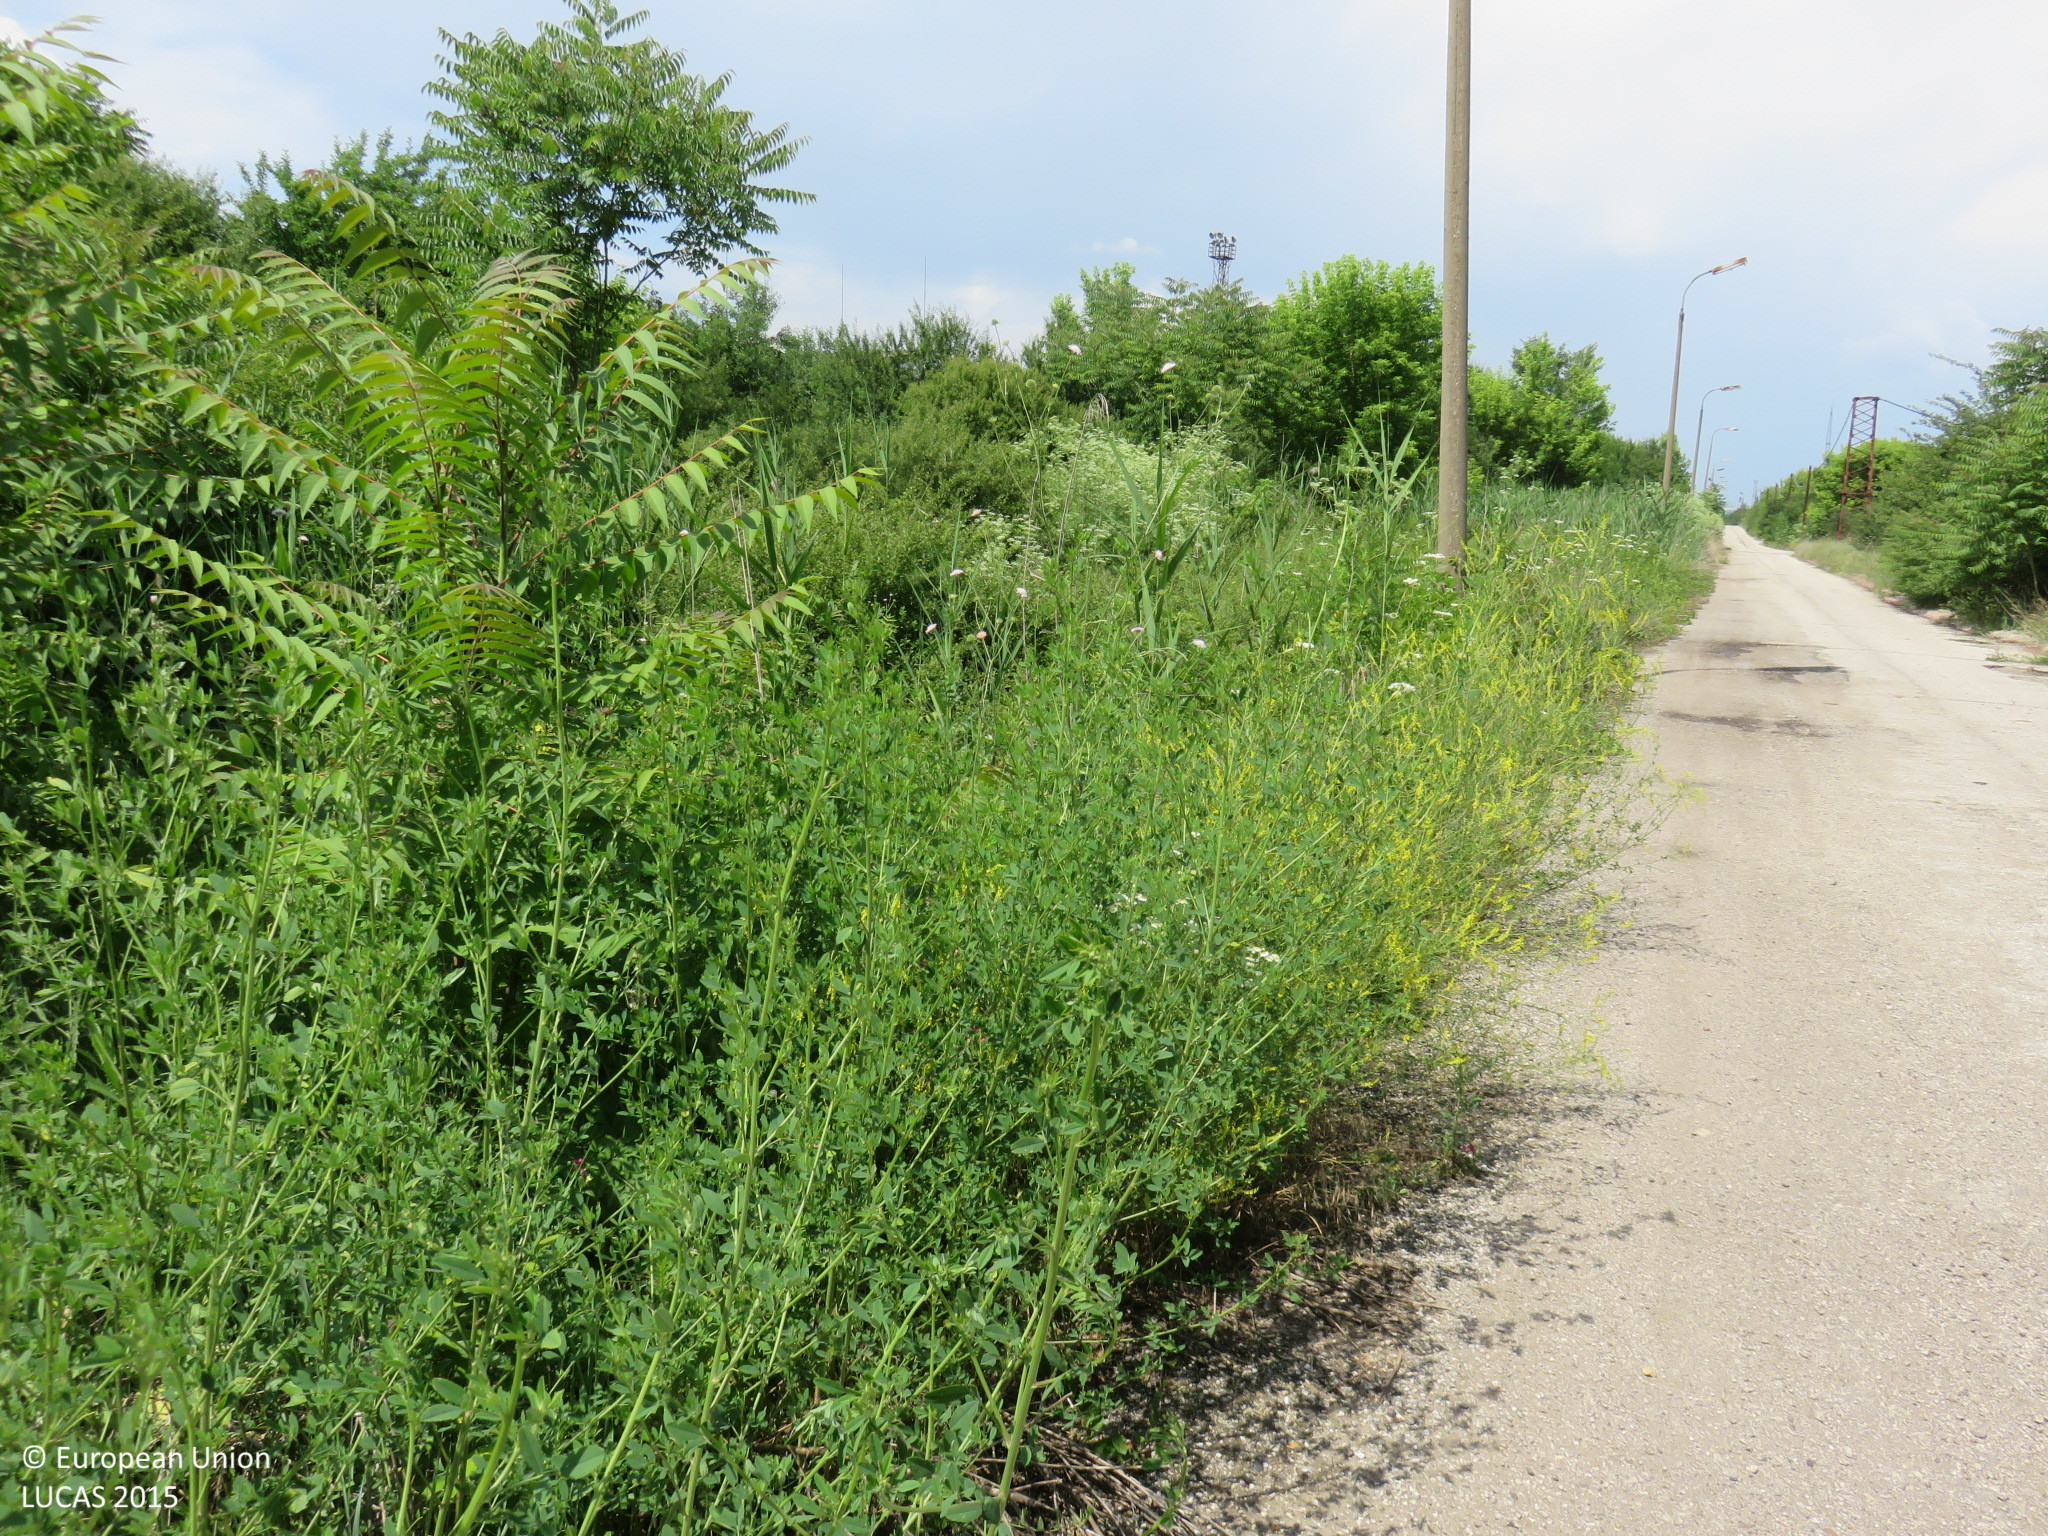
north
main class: Woodland
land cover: Broadleaved woodland
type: mesophytic deciduous forest
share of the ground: > 75 %
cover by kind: broadleaved forest trees 80 %, shrubs 15 %, herbaceous plants 5 %
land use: Semi-natural and natural areas not in use
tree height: < 5 m
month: June
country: BG
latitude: 43.3998
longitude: 24.4942
